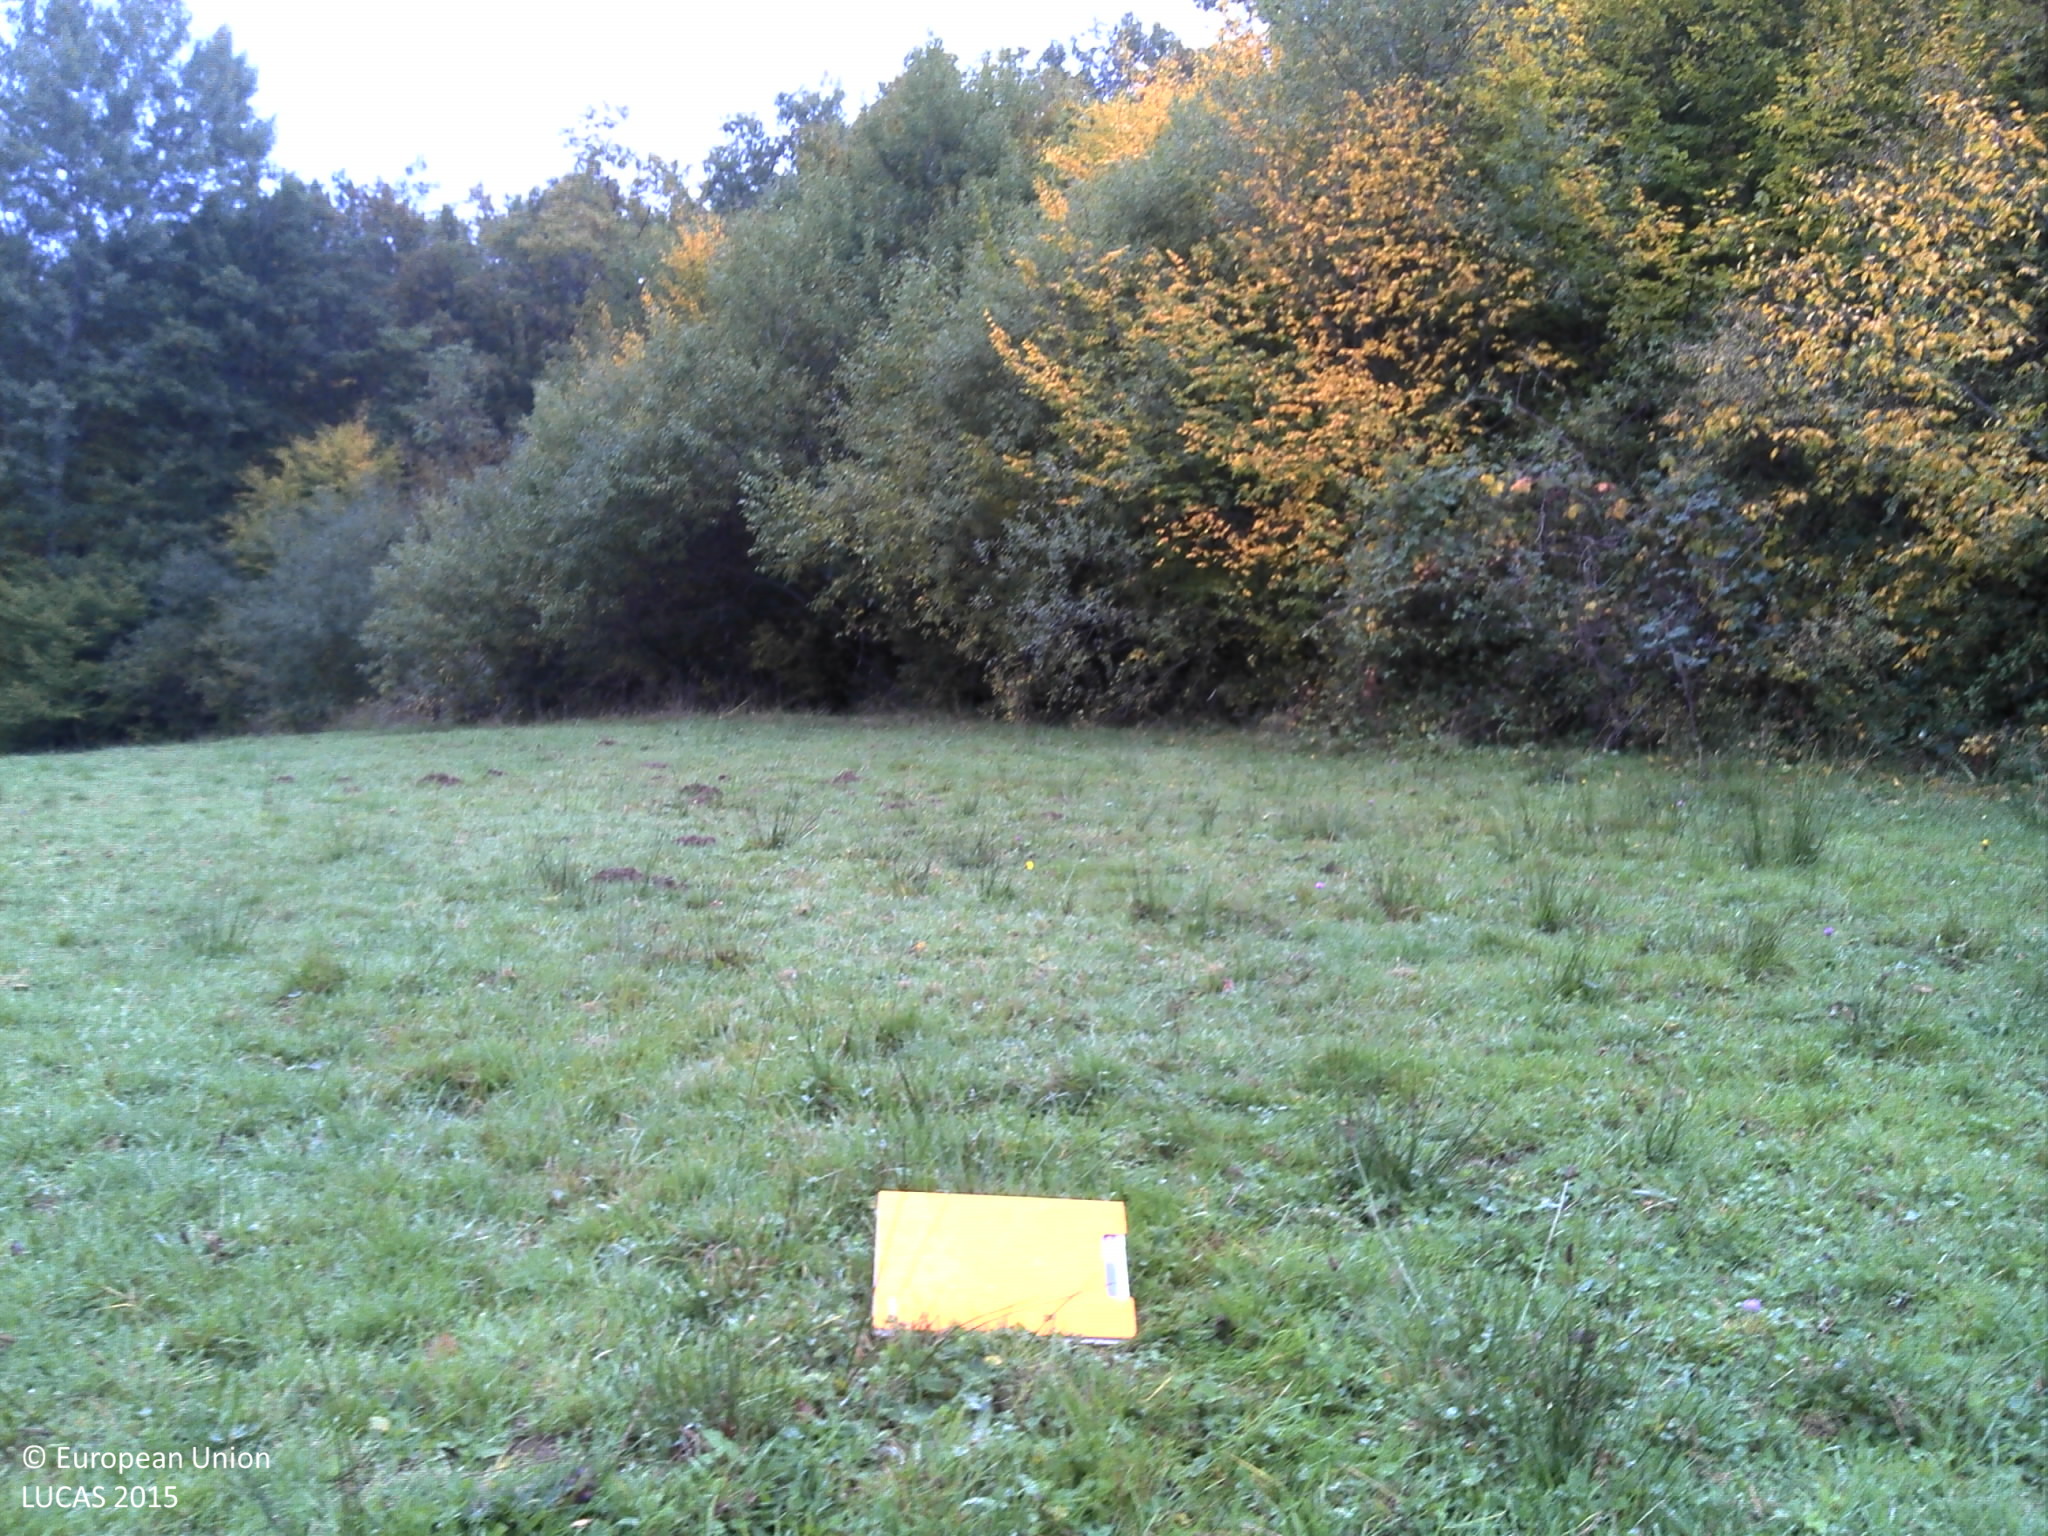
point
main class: Grassland
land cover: Grassland without tree/shrub cover
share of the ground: > 75 %
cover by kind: herbaceous plants 100 %
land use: Agriculture (excluding fallow land and kitchen gardens)
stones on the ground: < 10 %
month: October
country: FR
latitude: 45.6425
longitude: 3.4193
